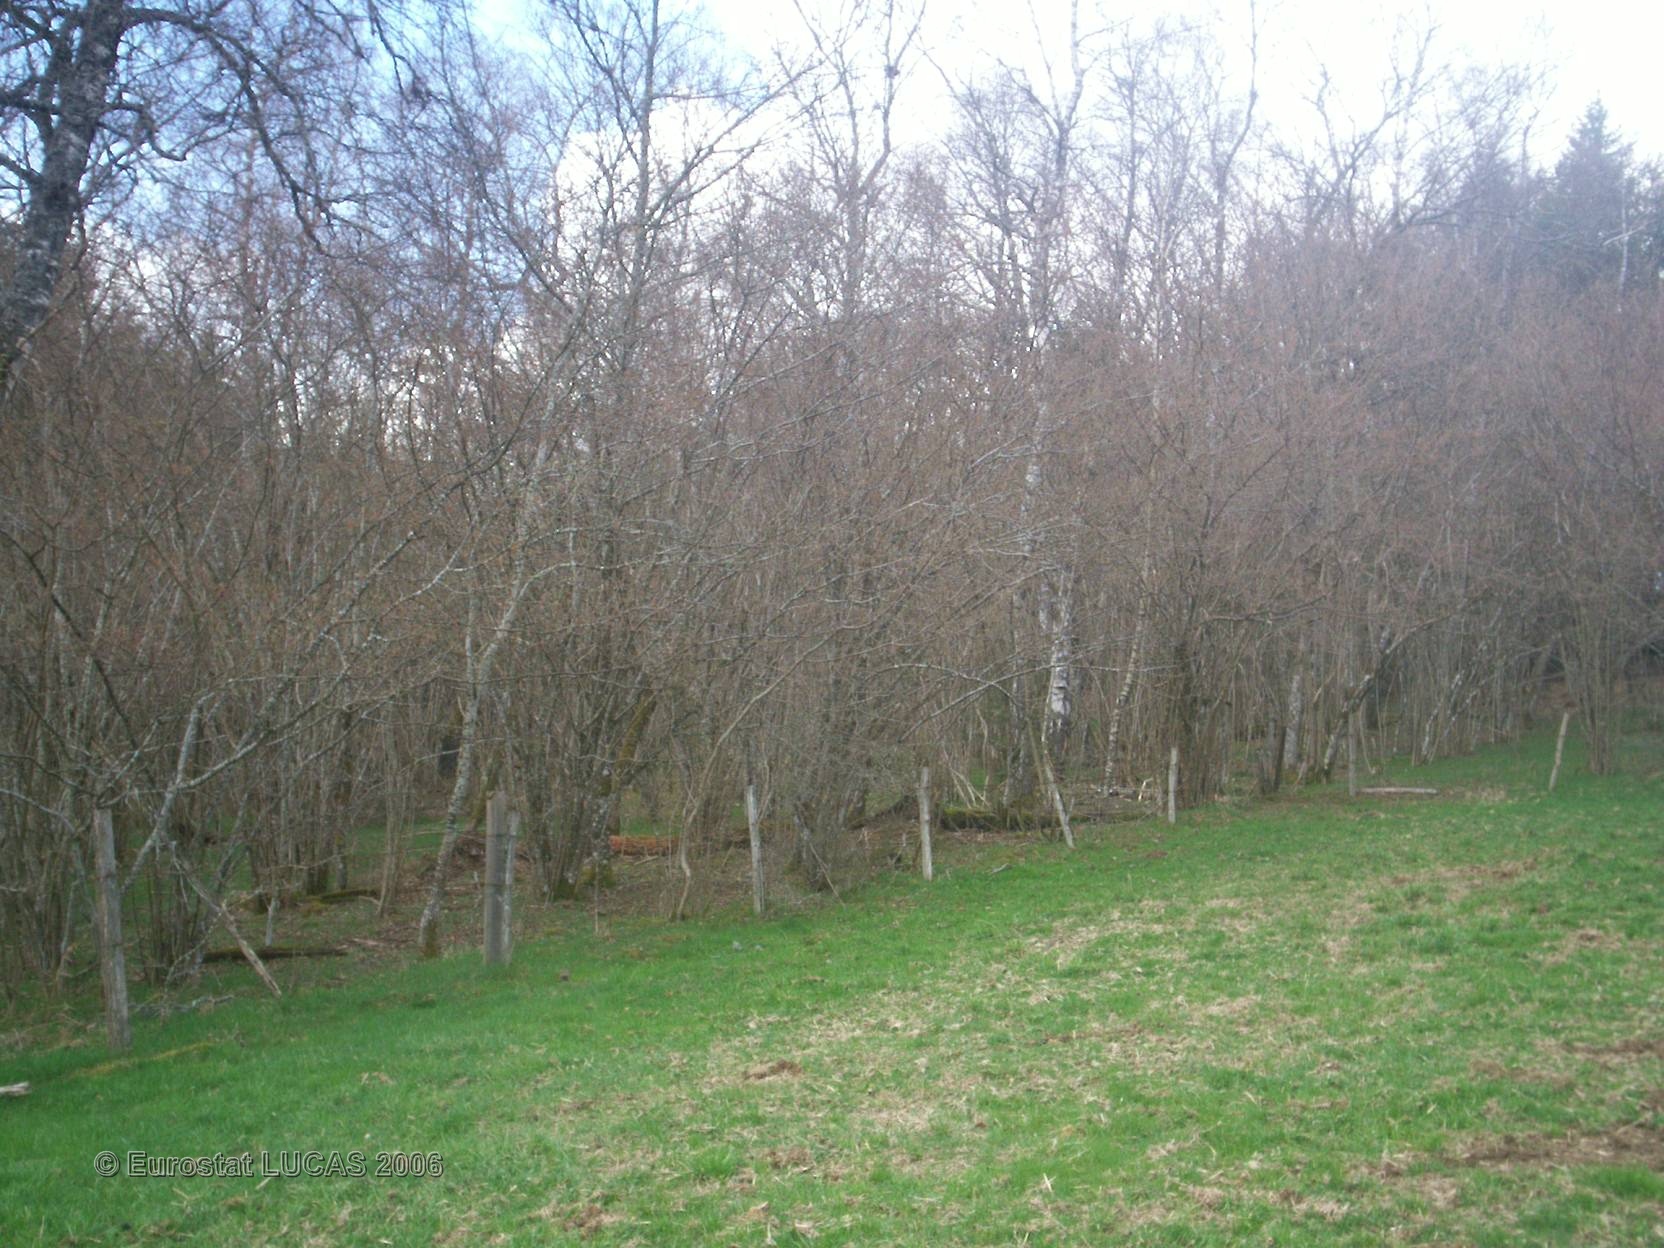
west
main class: Grassland
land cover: Grassland without tree/shrub cover
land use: Agriculture (excluding fallow land and kitchen gardens)
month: April
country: FR
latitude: 45.8101
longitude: 2.9343
